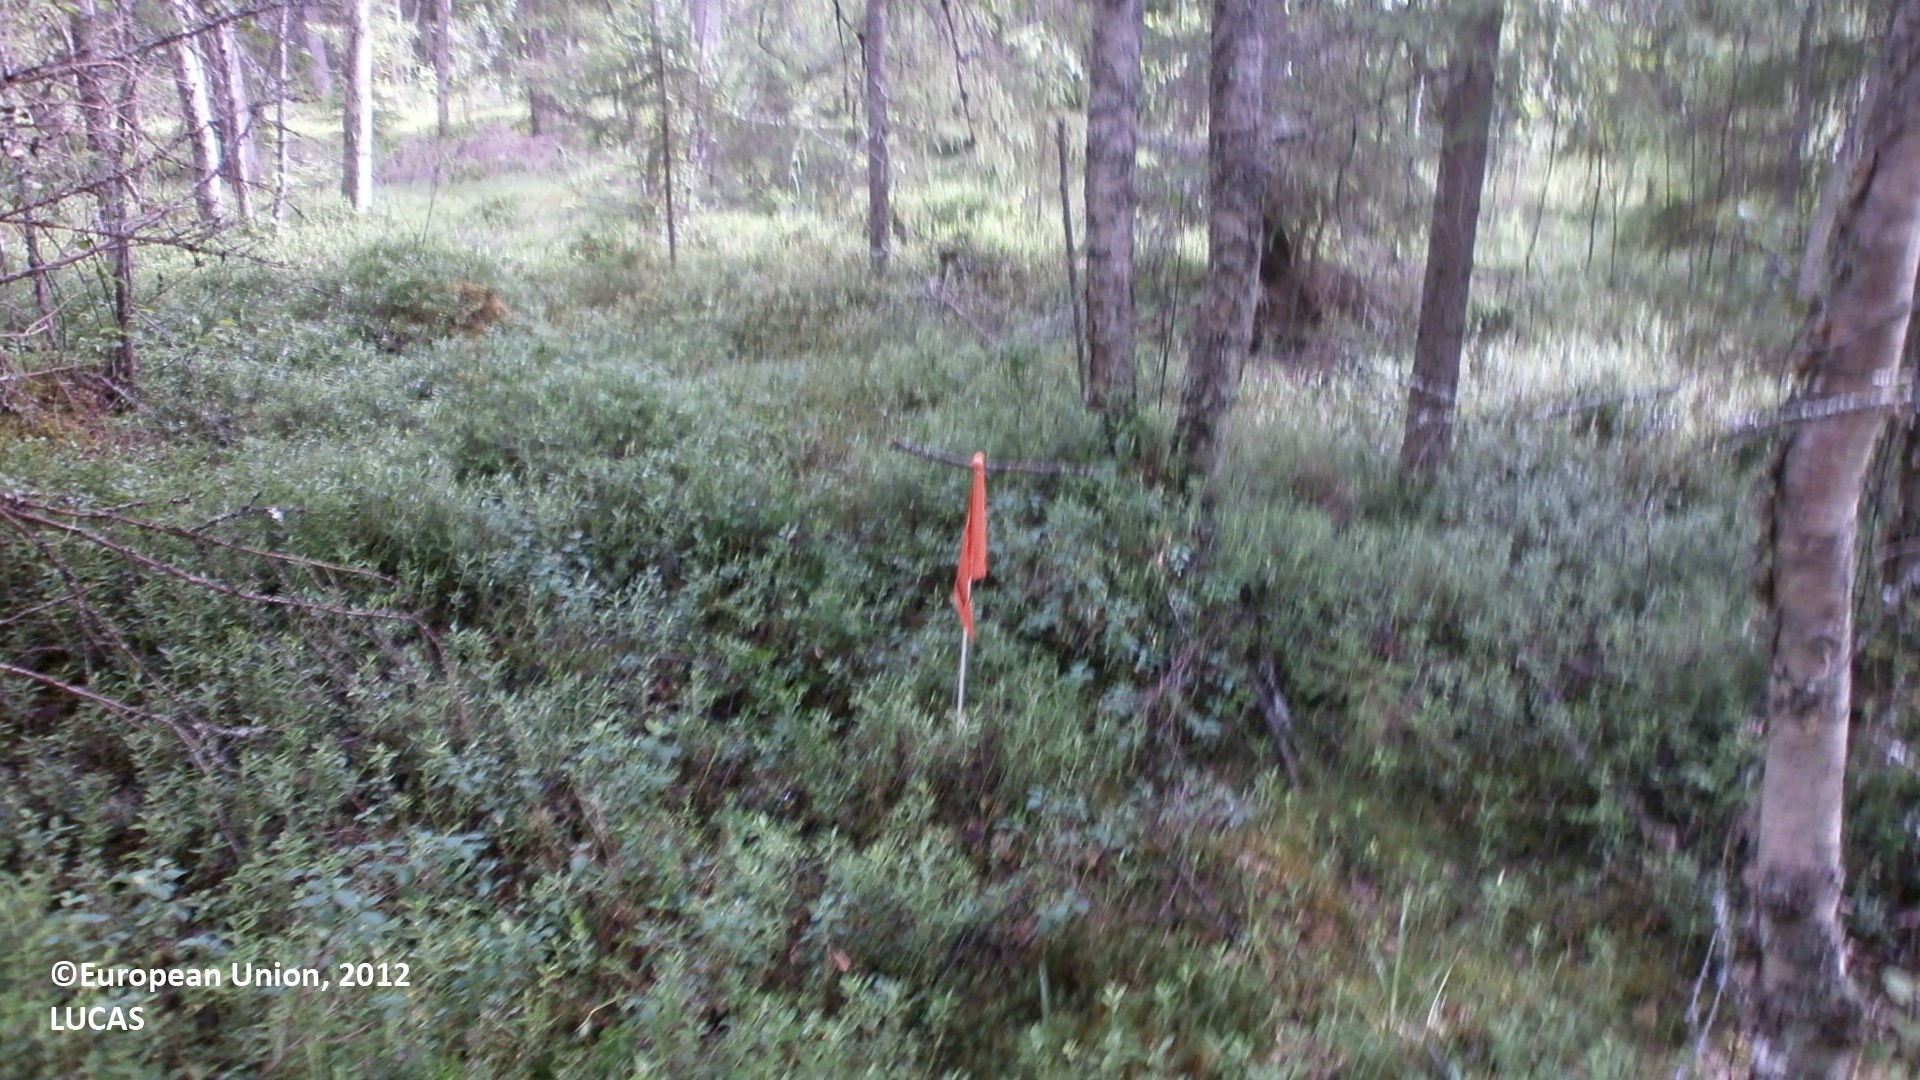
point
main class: Woodland
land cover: Spruce dominated mixed woodland
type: boreal forest
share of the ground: > 75 %
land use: Forestry
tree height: > 5 m
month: July
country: FI
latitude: 64.5305
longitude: 24.3849
